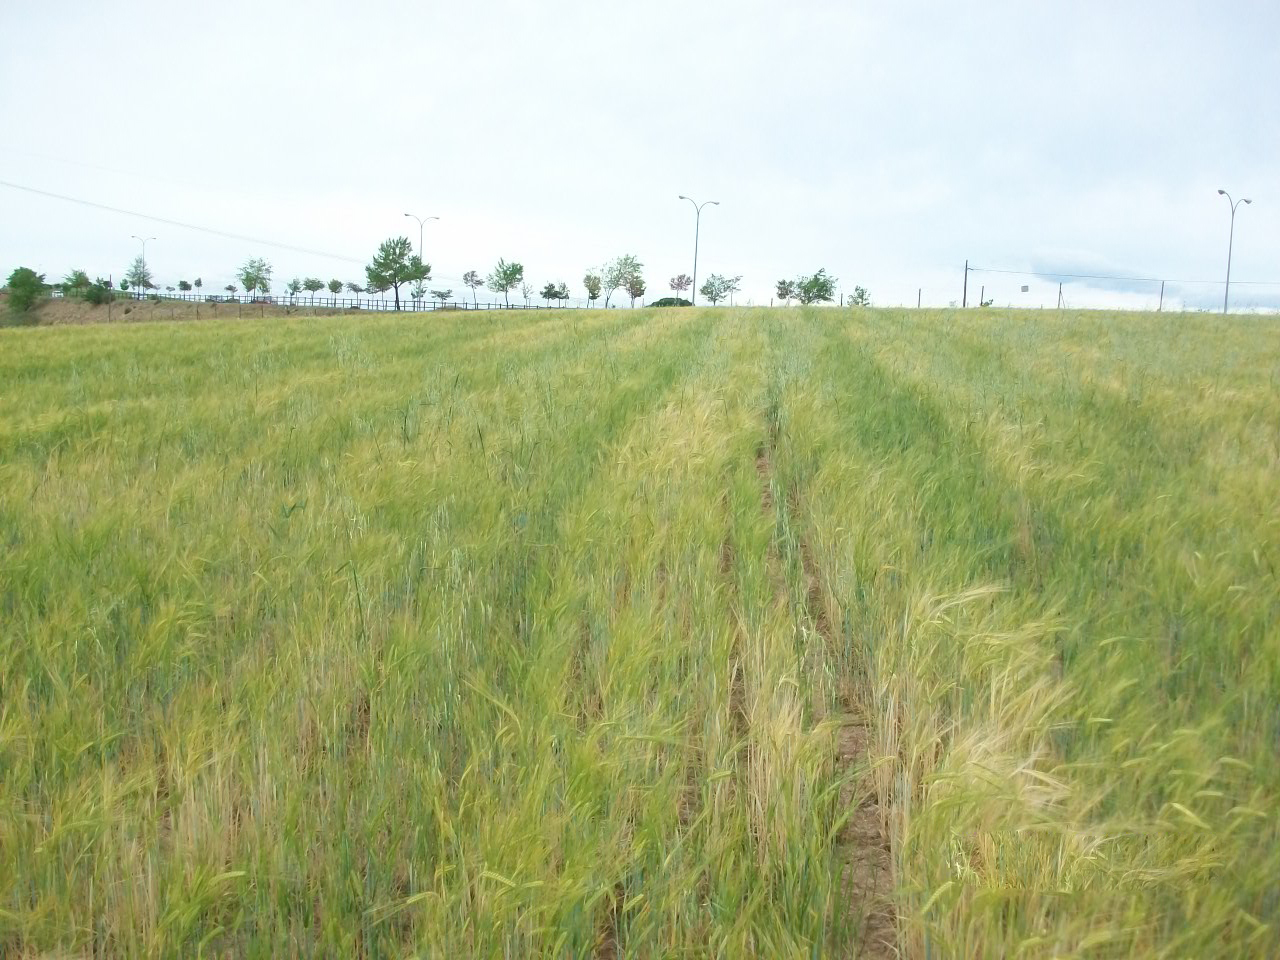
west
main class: Cropland
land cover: Barley
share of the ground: > 75 %
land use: Agriculture (excluding fallow land and kitchen gardens)
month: April
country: ES
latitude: 40.2975
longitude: -3.9091
